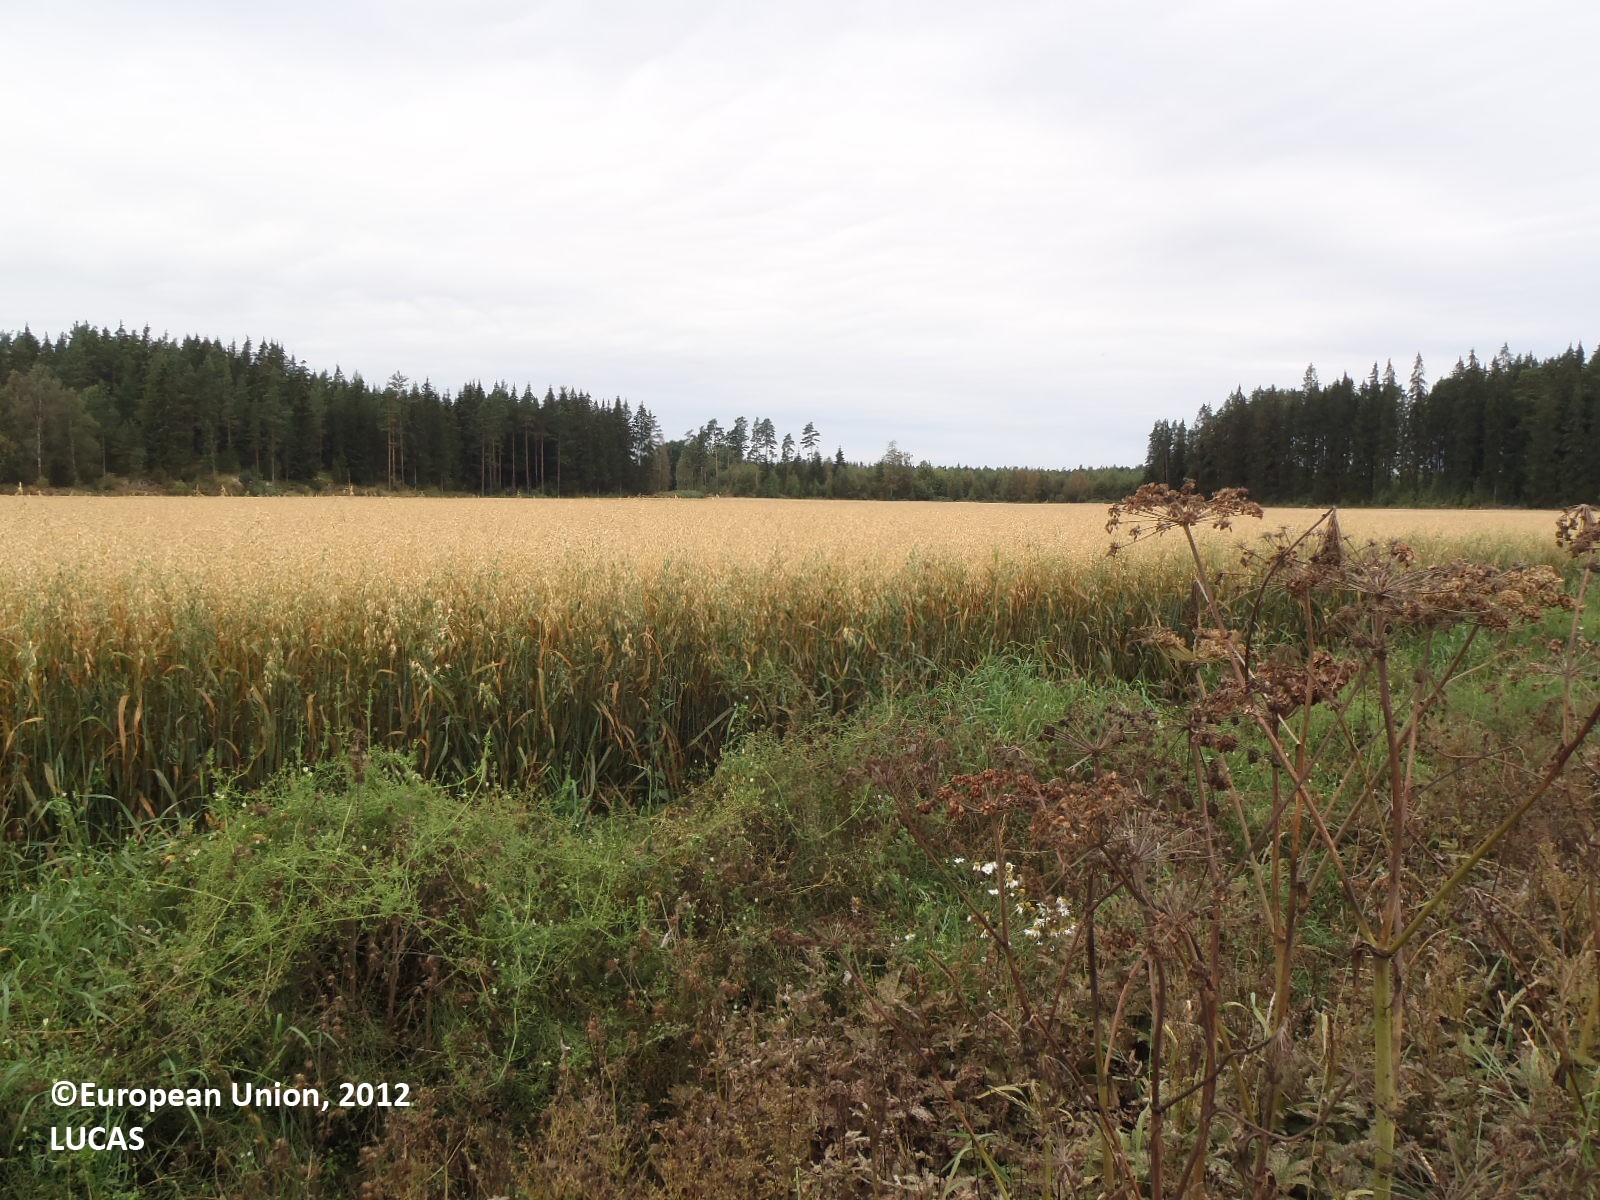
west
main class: Cropland
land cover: Common wheat
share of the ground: > 75 %
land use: Agriculture (excluding fallow land and kitchen gardens)
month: August
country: FI
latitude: 60.8697
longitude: 21.7887
